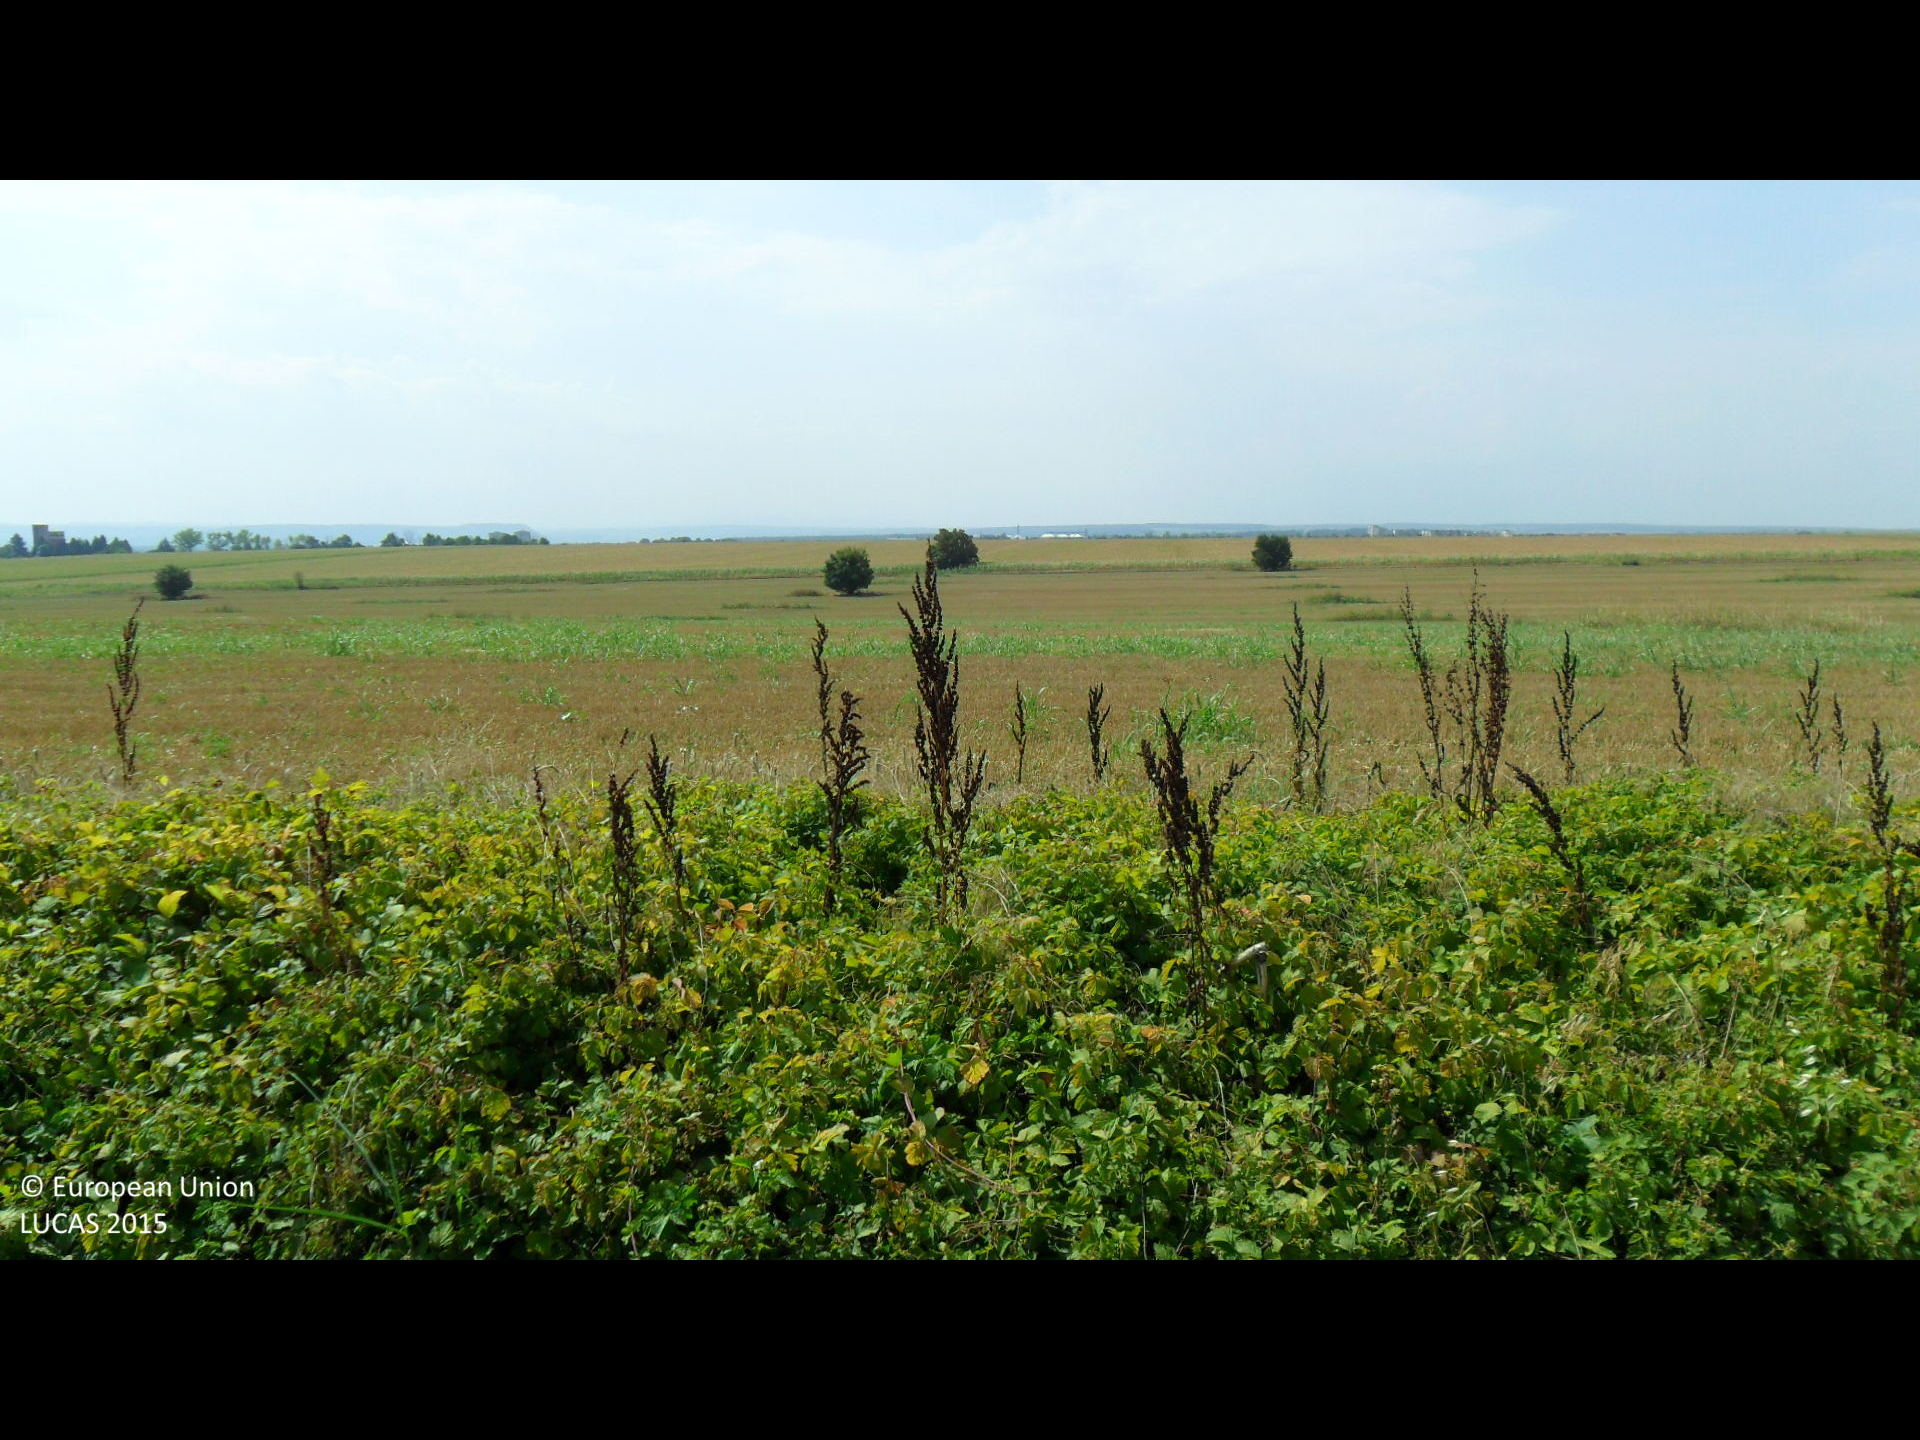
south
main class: Cropland
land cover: Barley
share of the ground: > 75 %
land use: Agriculture (excluding fallow land and kitchen gardens)
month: August
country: BG
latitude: 43.3752
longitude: 26.2277
